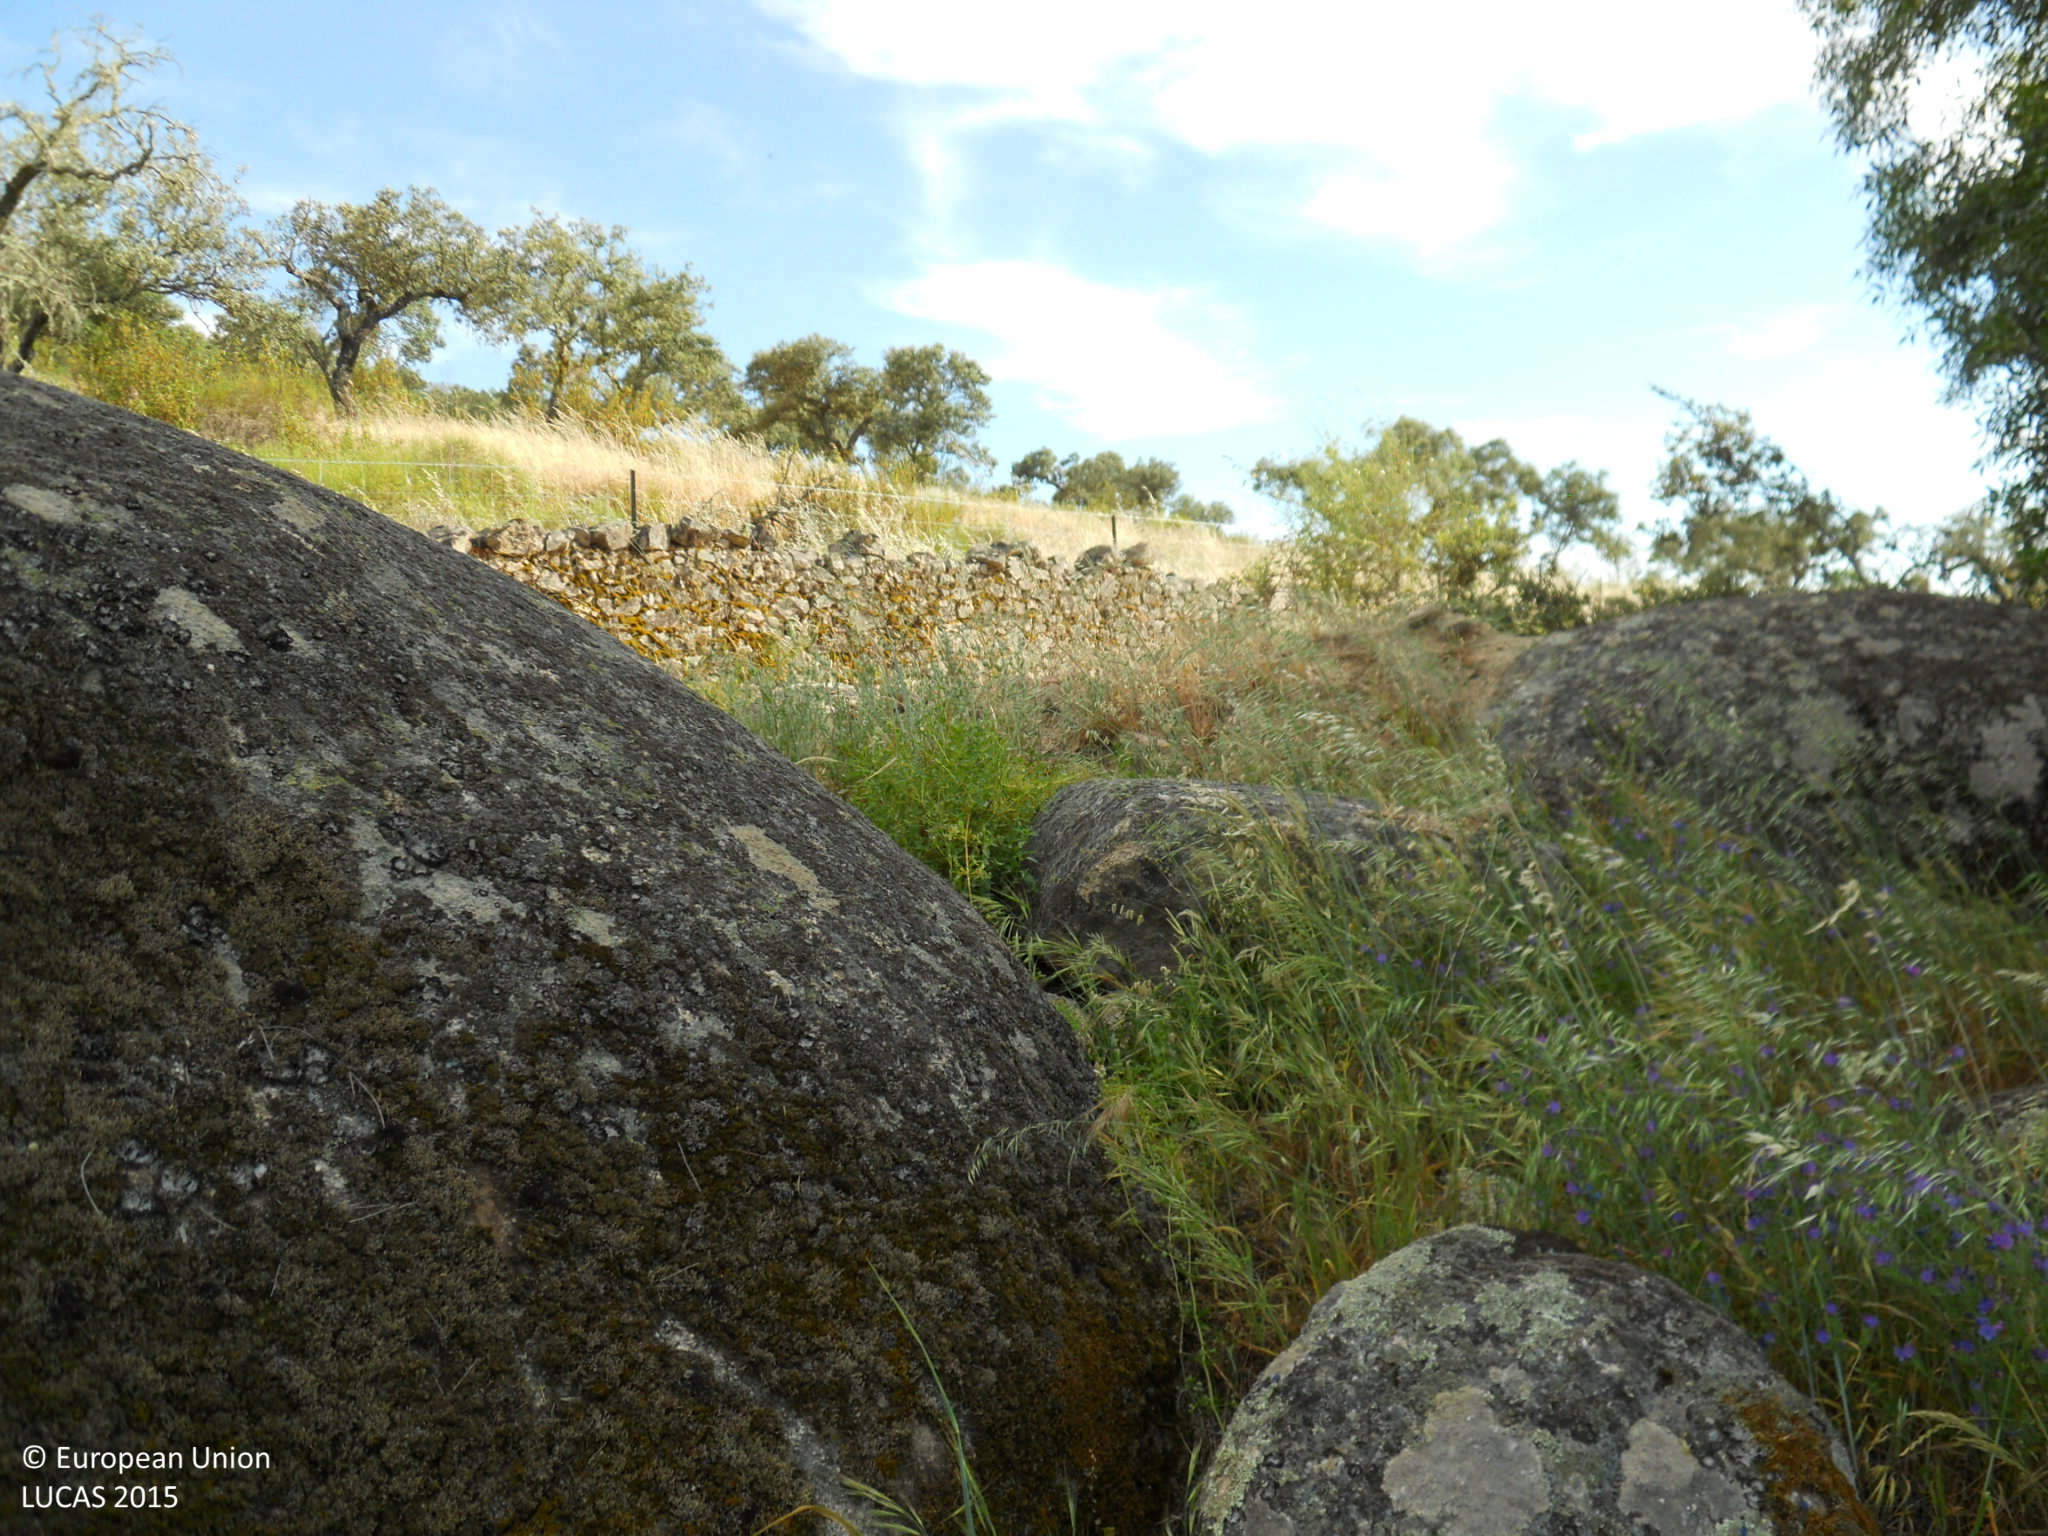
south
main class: Shrubland
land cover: Shrubland with sparse tree cover
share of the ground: > 75 %
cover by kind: shrubs 80 %, herbaceous plants 10 %, broadleaved forest trees 5 %, consolidated bare surface 5 %
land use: Agriculture (excluding fallow land and kitchen gardens)
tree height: > 5 m
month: May
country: ES
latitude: 39.0602
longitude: -6.2962
